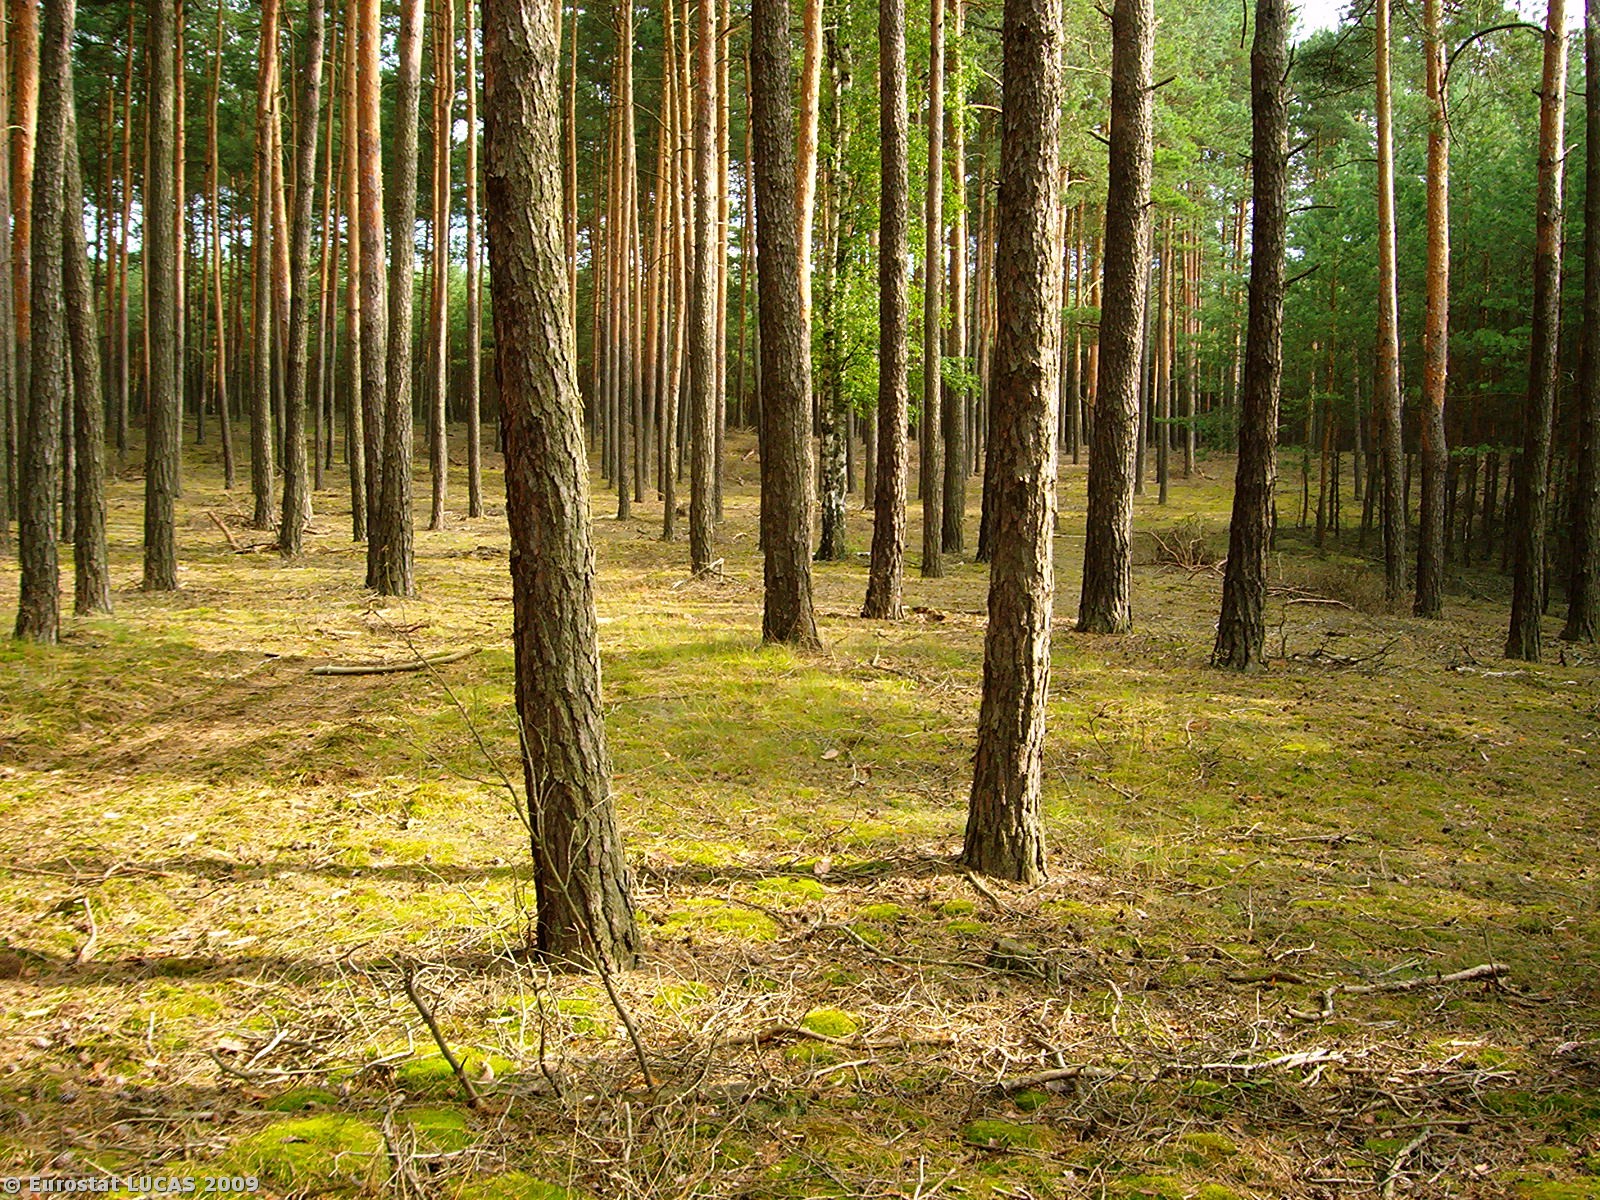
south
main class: Woodland
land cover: Coniferous woodland
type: hemiboreal forest and nemoral coniferous forest and mixed broadleaved-coniferous forest
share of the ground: 50 - 75 %
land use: Forestry
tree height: > 5 m
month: July
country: PL
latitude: 52.3838
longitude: 15.7198
